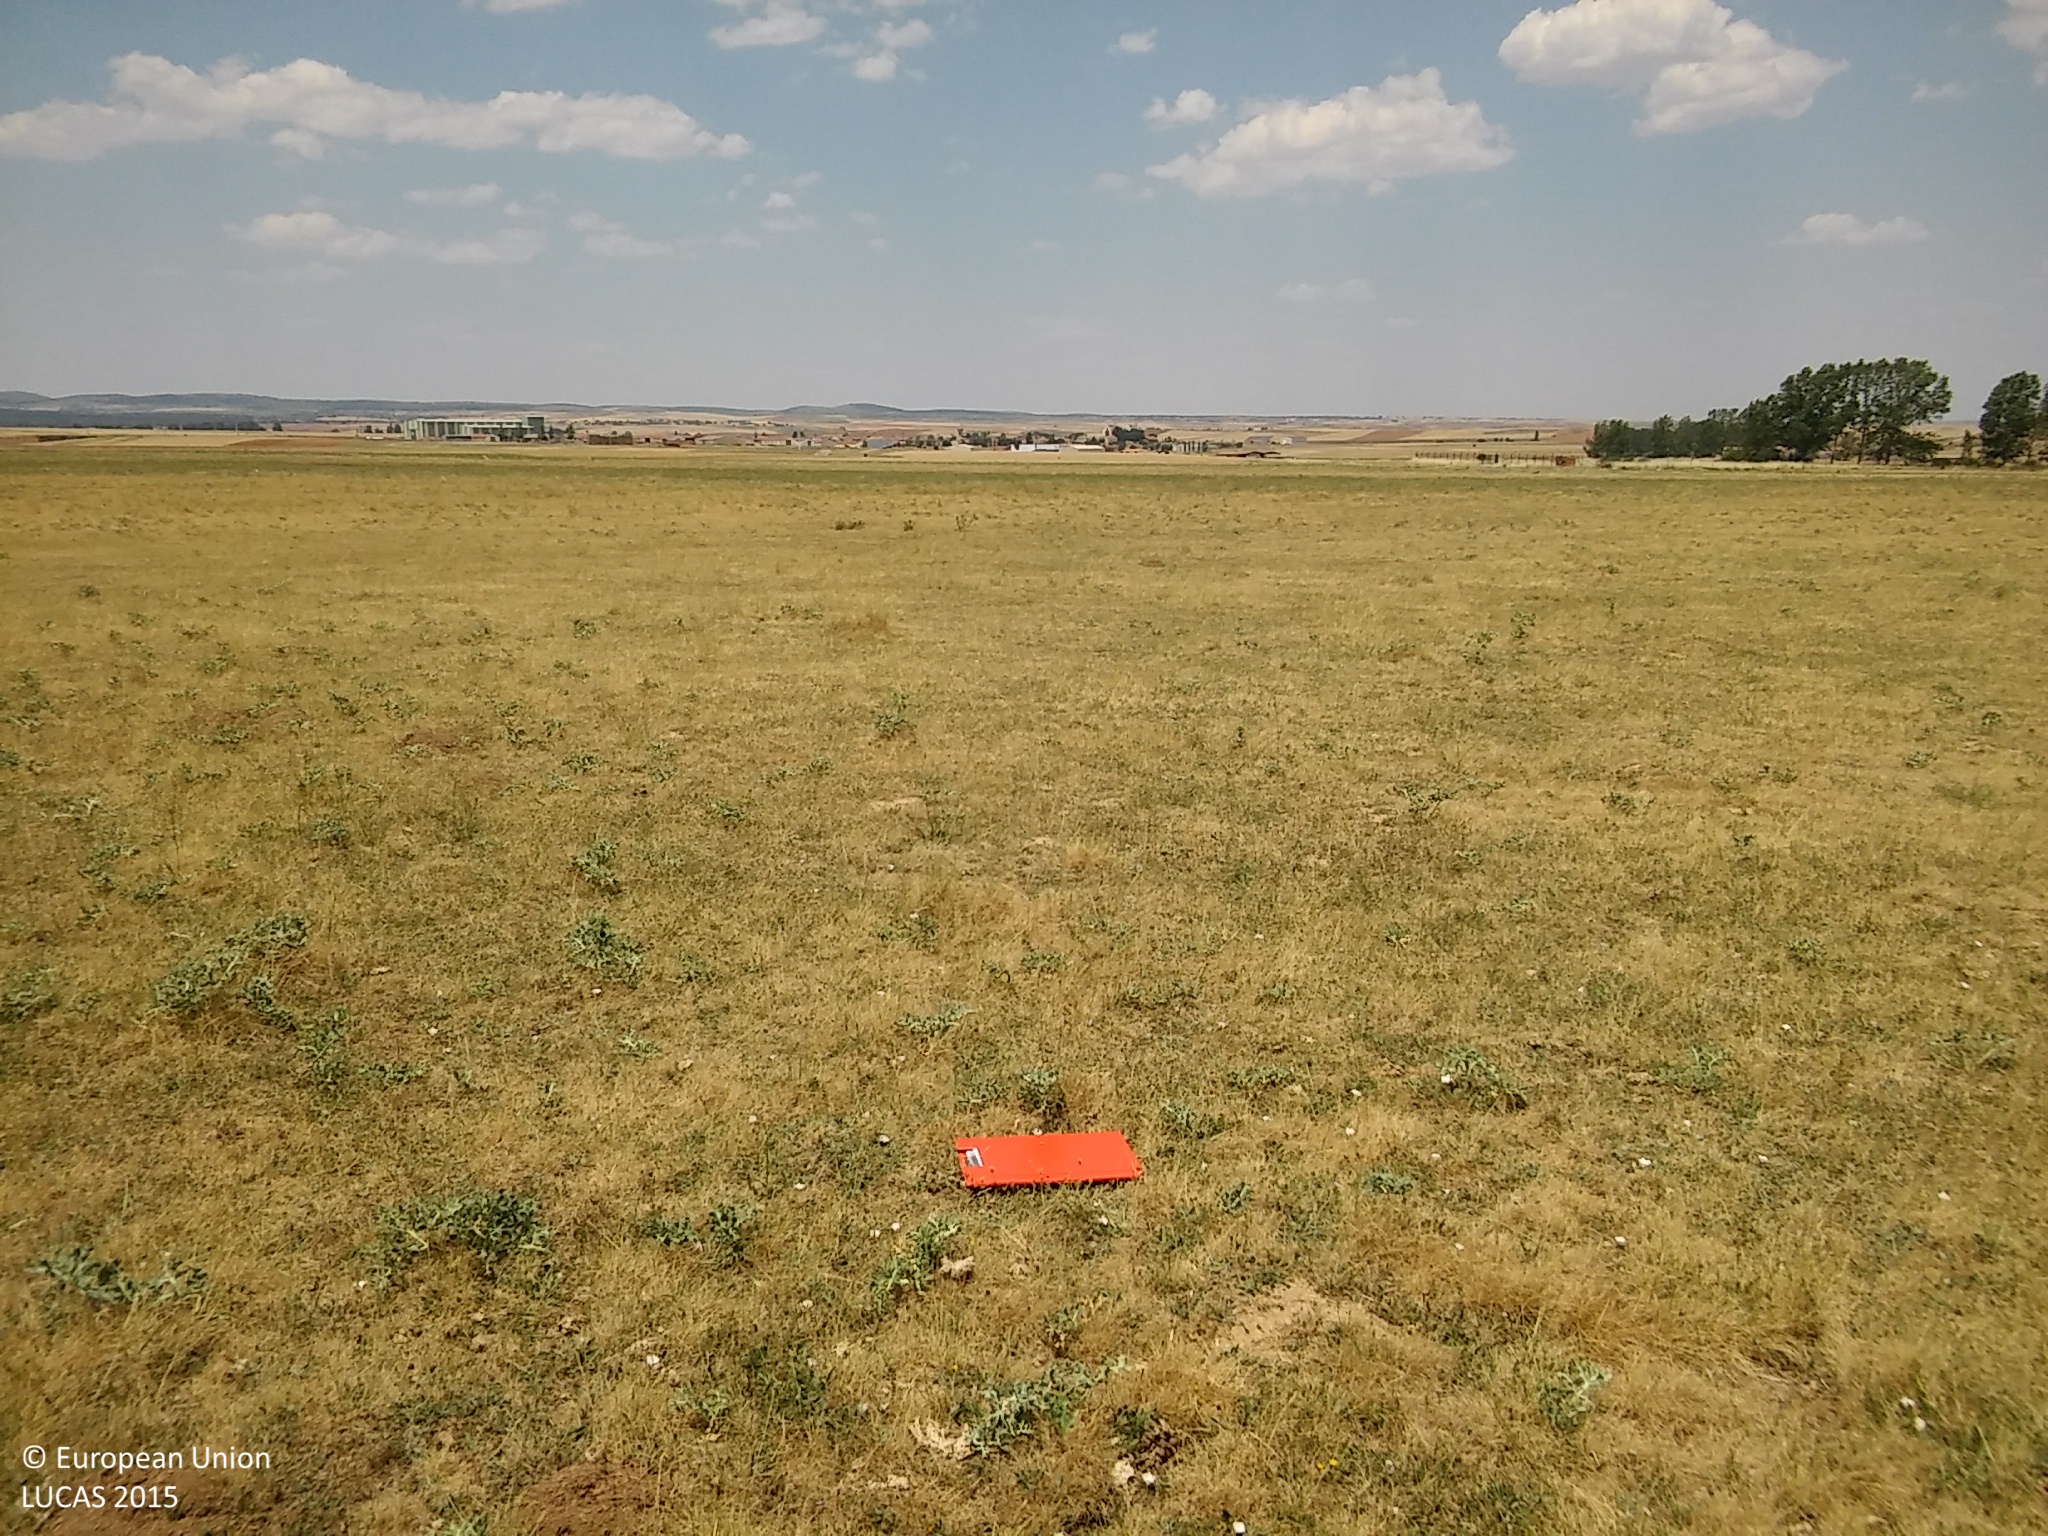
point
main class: Grassland
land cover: Grassland without tree/shrub cover
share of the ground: > 75 %
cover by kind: herbaceous plants 100 %
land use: Agriculture (excluding fallow land and kitchen gardens)
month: June
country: ES
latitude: 41.4123
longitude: -3.5302
